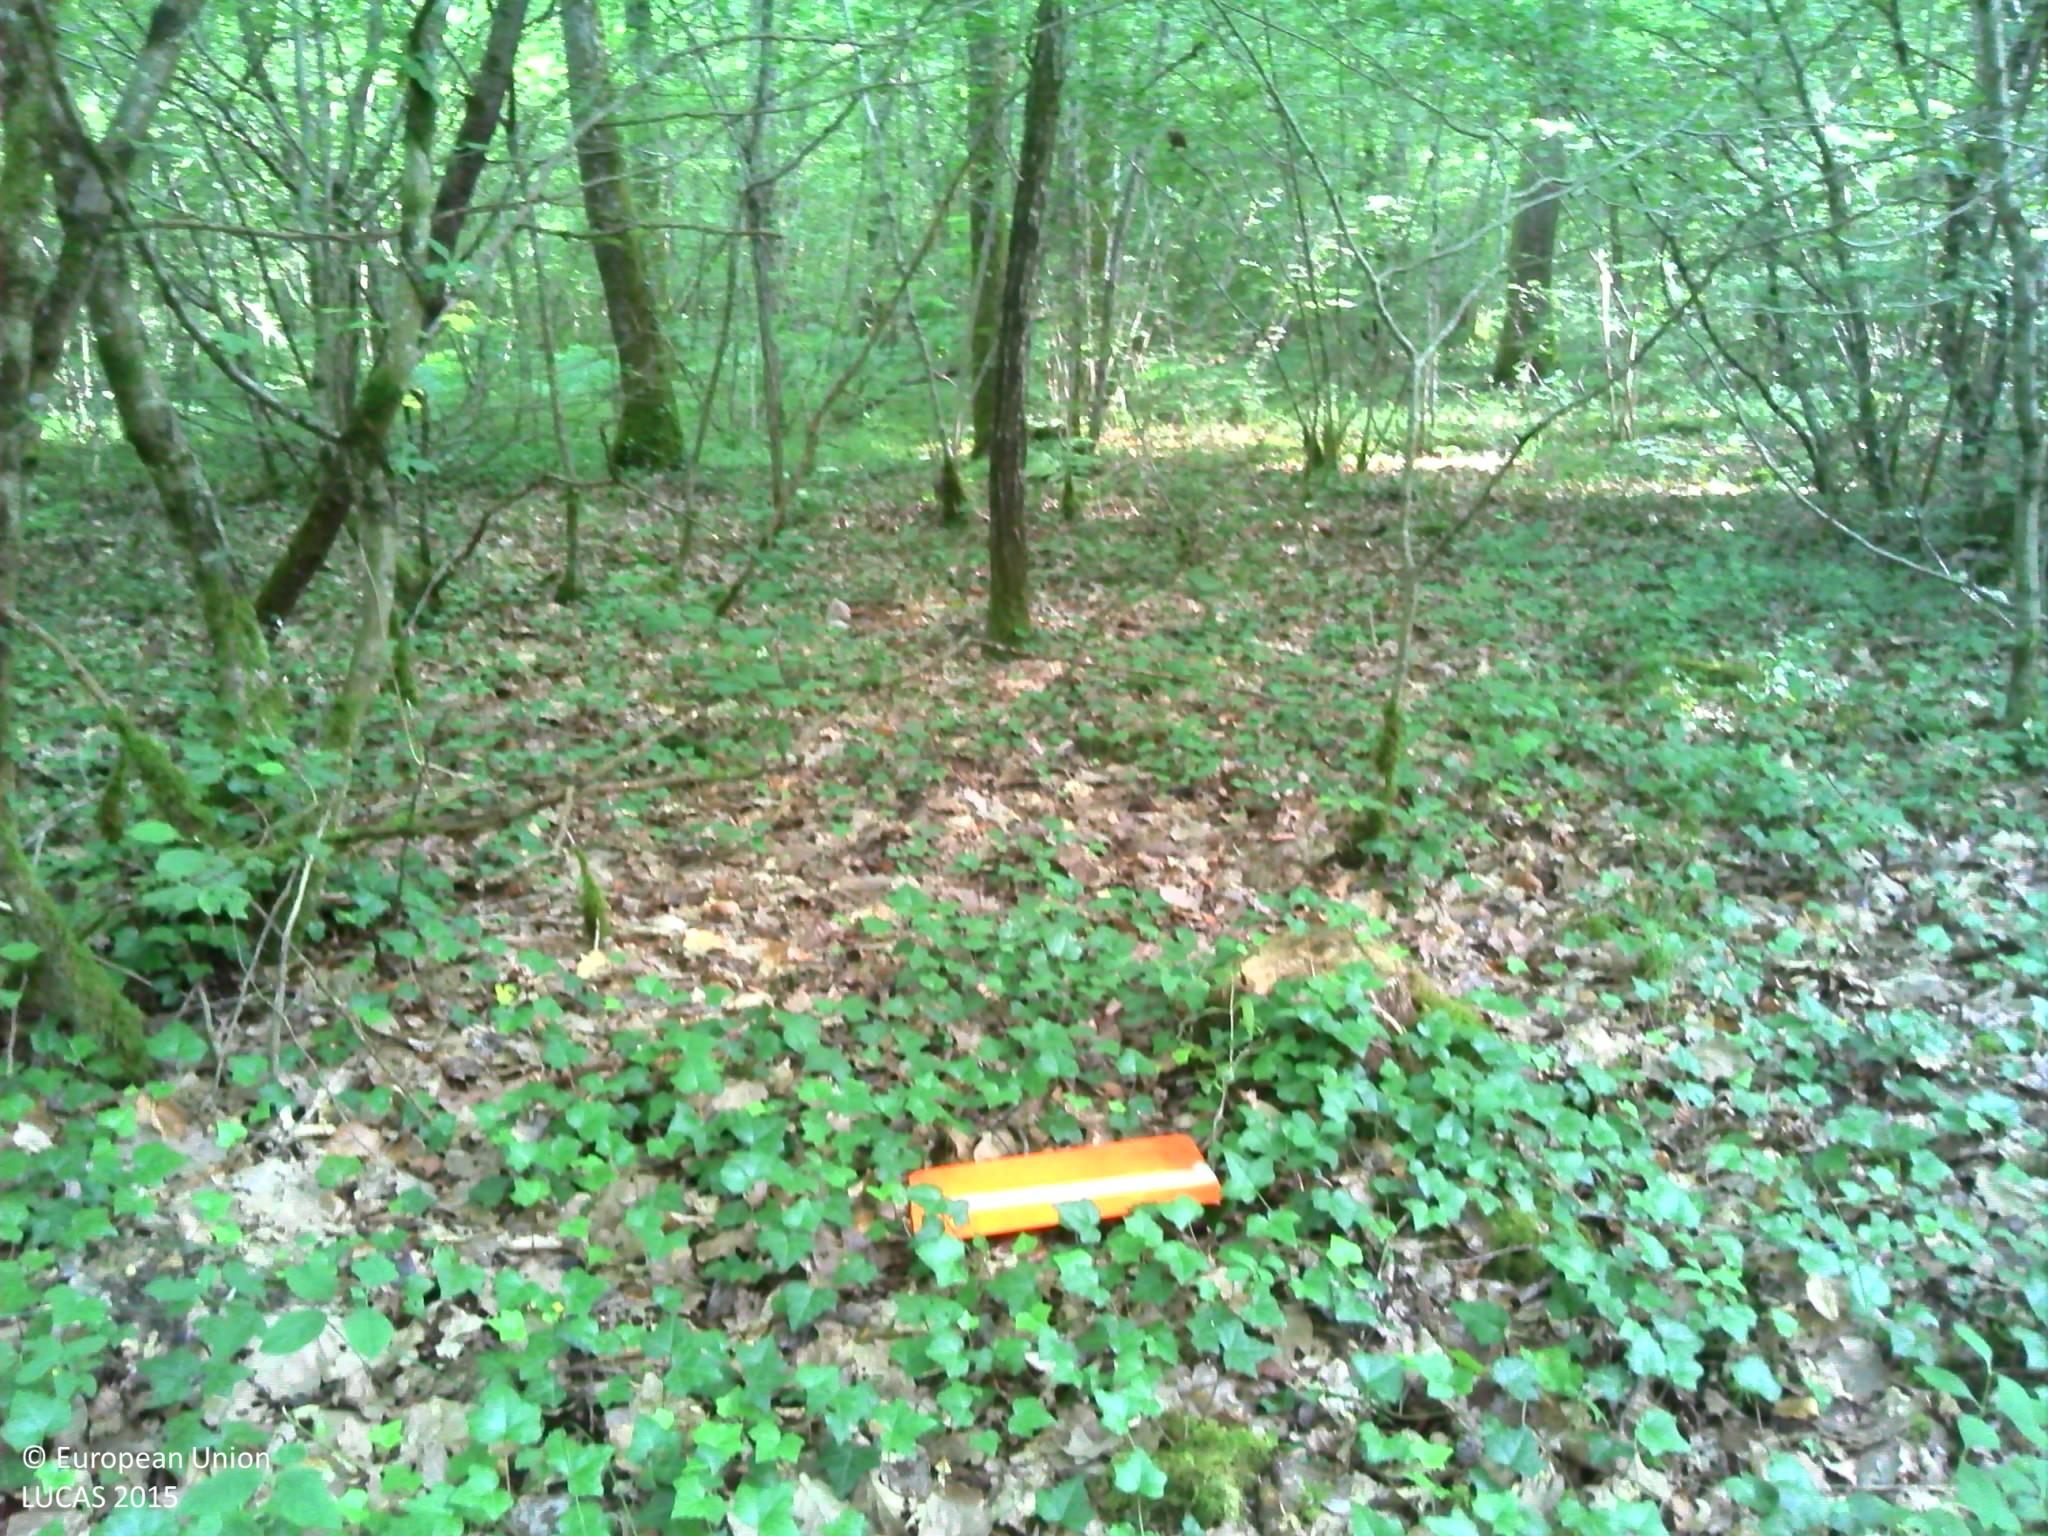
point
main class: Woodland
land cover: Broadleaved woodland
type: mesophytic deciduous forest
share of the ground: > 75 %
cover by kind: broadleaved forest trees 95 %, herbaceous plants 5 %
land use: Forestry
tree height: > 5 m
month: June
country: FR
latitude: 46.9406
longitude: 5.4696
